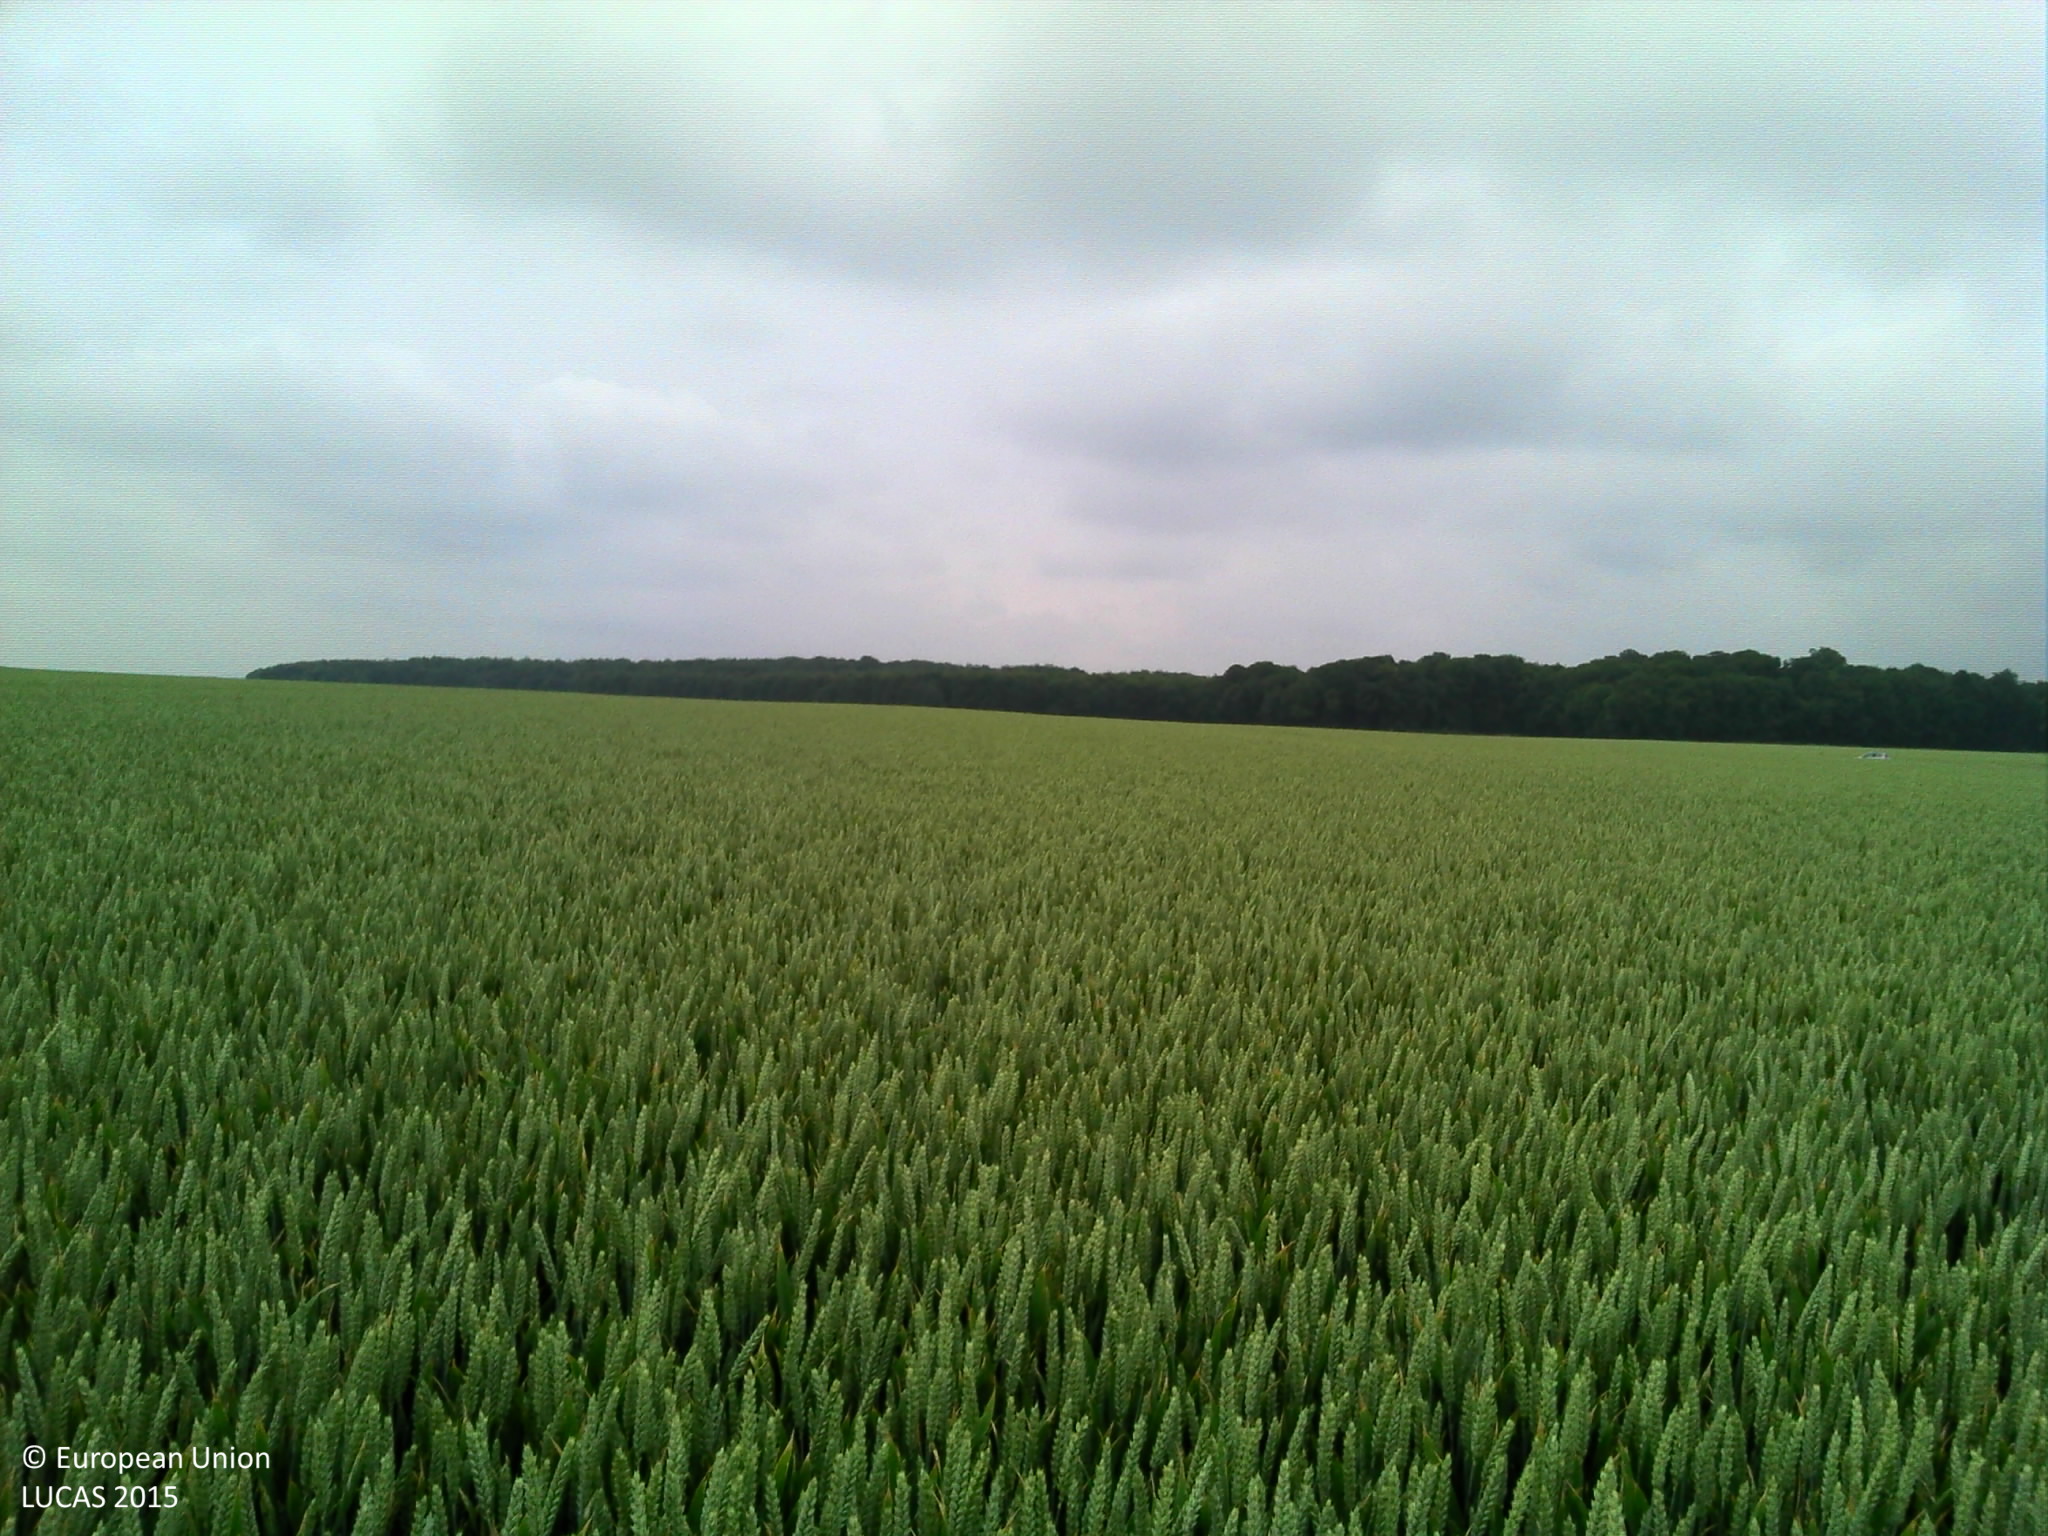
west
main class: Cropland
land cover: Common wheat
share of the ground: > 75 %
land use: Agriculture (excluding fallow land and kitchen gardens)
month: June
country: FR
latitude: 49.3150
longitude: 2.9336
